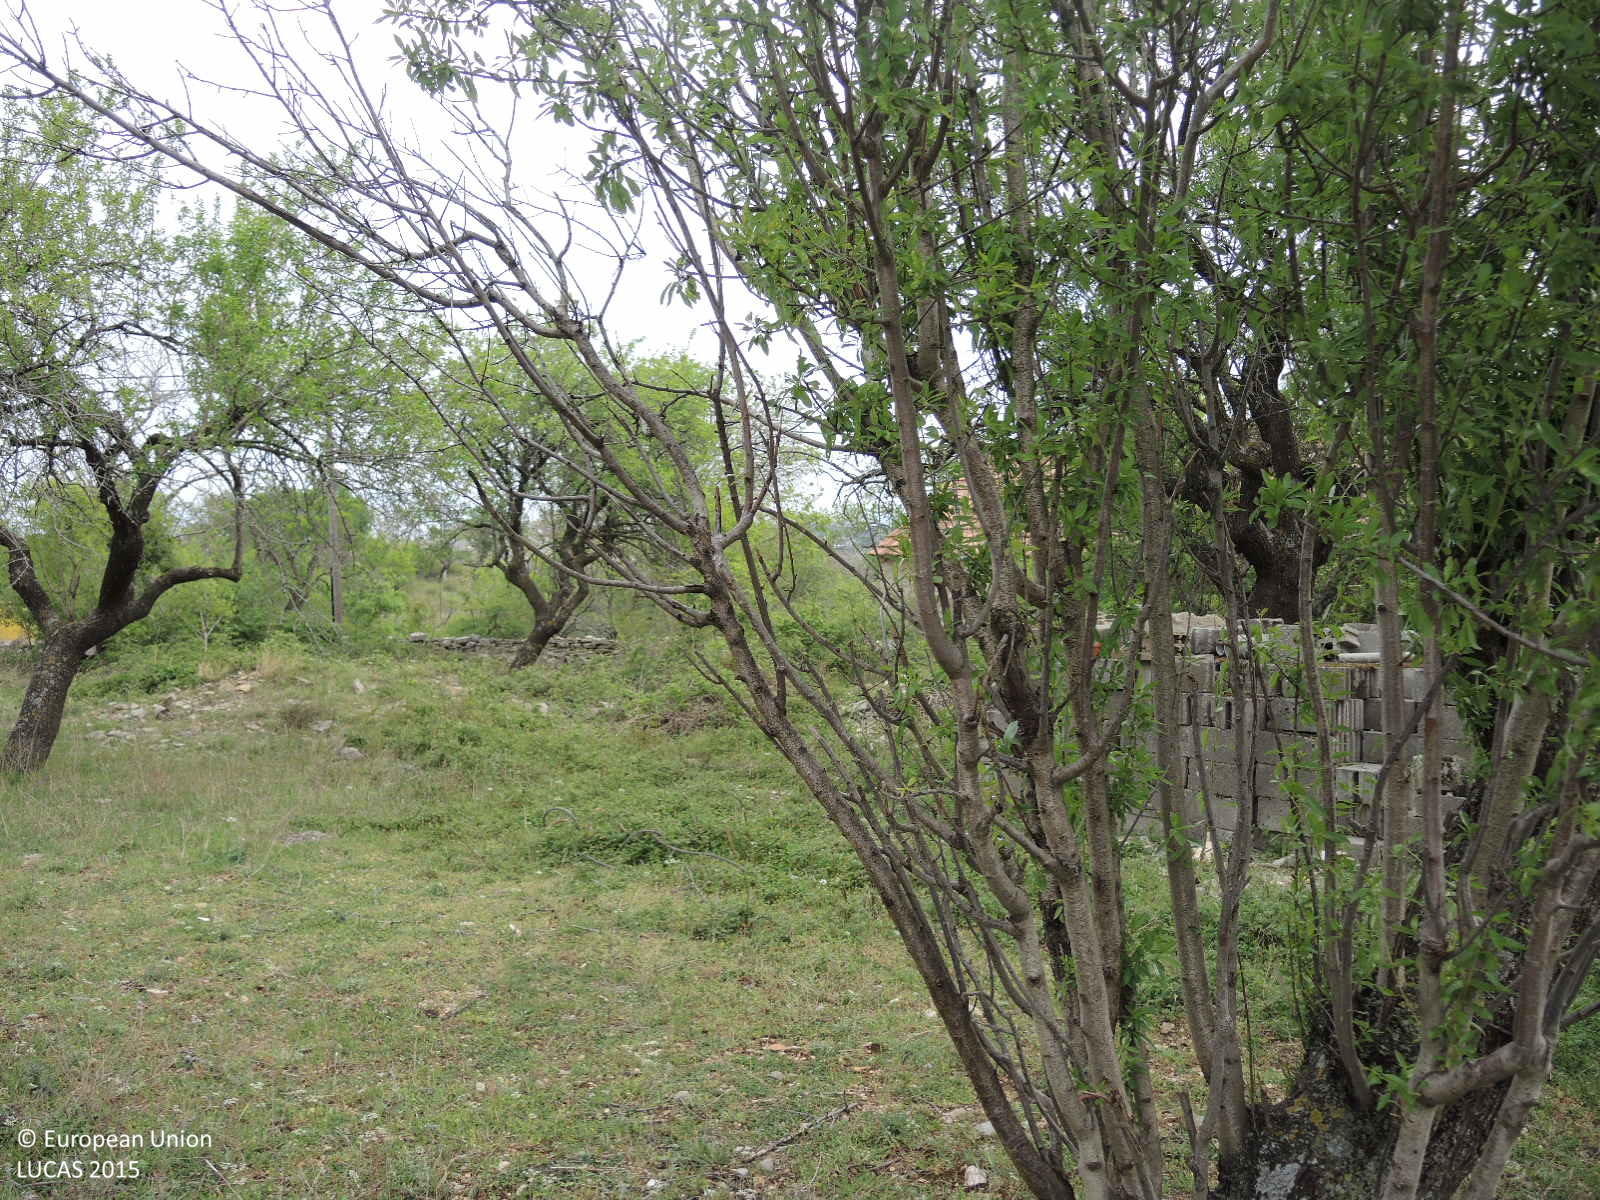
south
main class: Cropland
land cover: Nuts trees
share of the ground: 25 - 50 %
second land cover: Grassland without tree/shrub cover
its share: > 75 %
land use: Kitchen garden
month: April
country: HR
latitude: 44.0549
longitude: 15.5965
